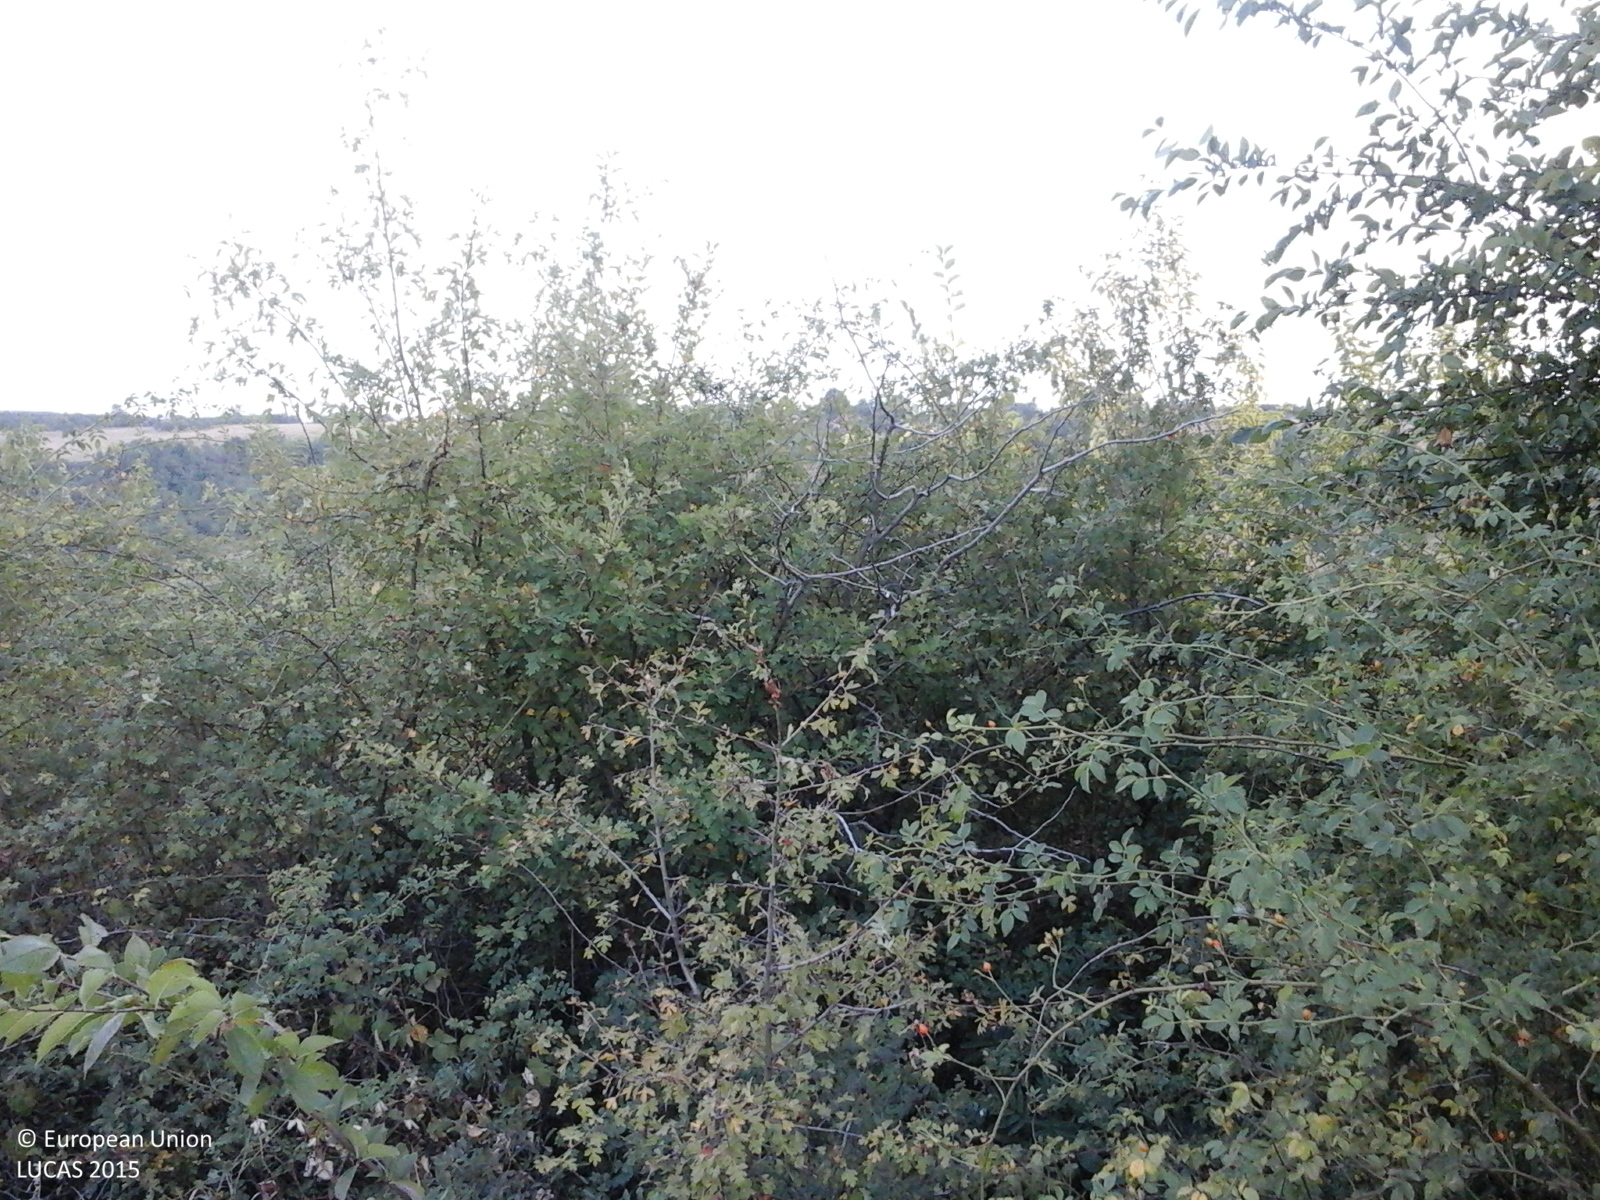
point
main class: Shrubland
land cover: Shrubland with sparse tree cover
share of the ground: > 75 %
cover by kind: shrubs 95 %, broadleaved forest trees 5 %
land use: Semi-natural and natural areas not in use
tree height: < 5 m
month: August
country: RO
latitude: 44.4276
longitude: 23.5317
